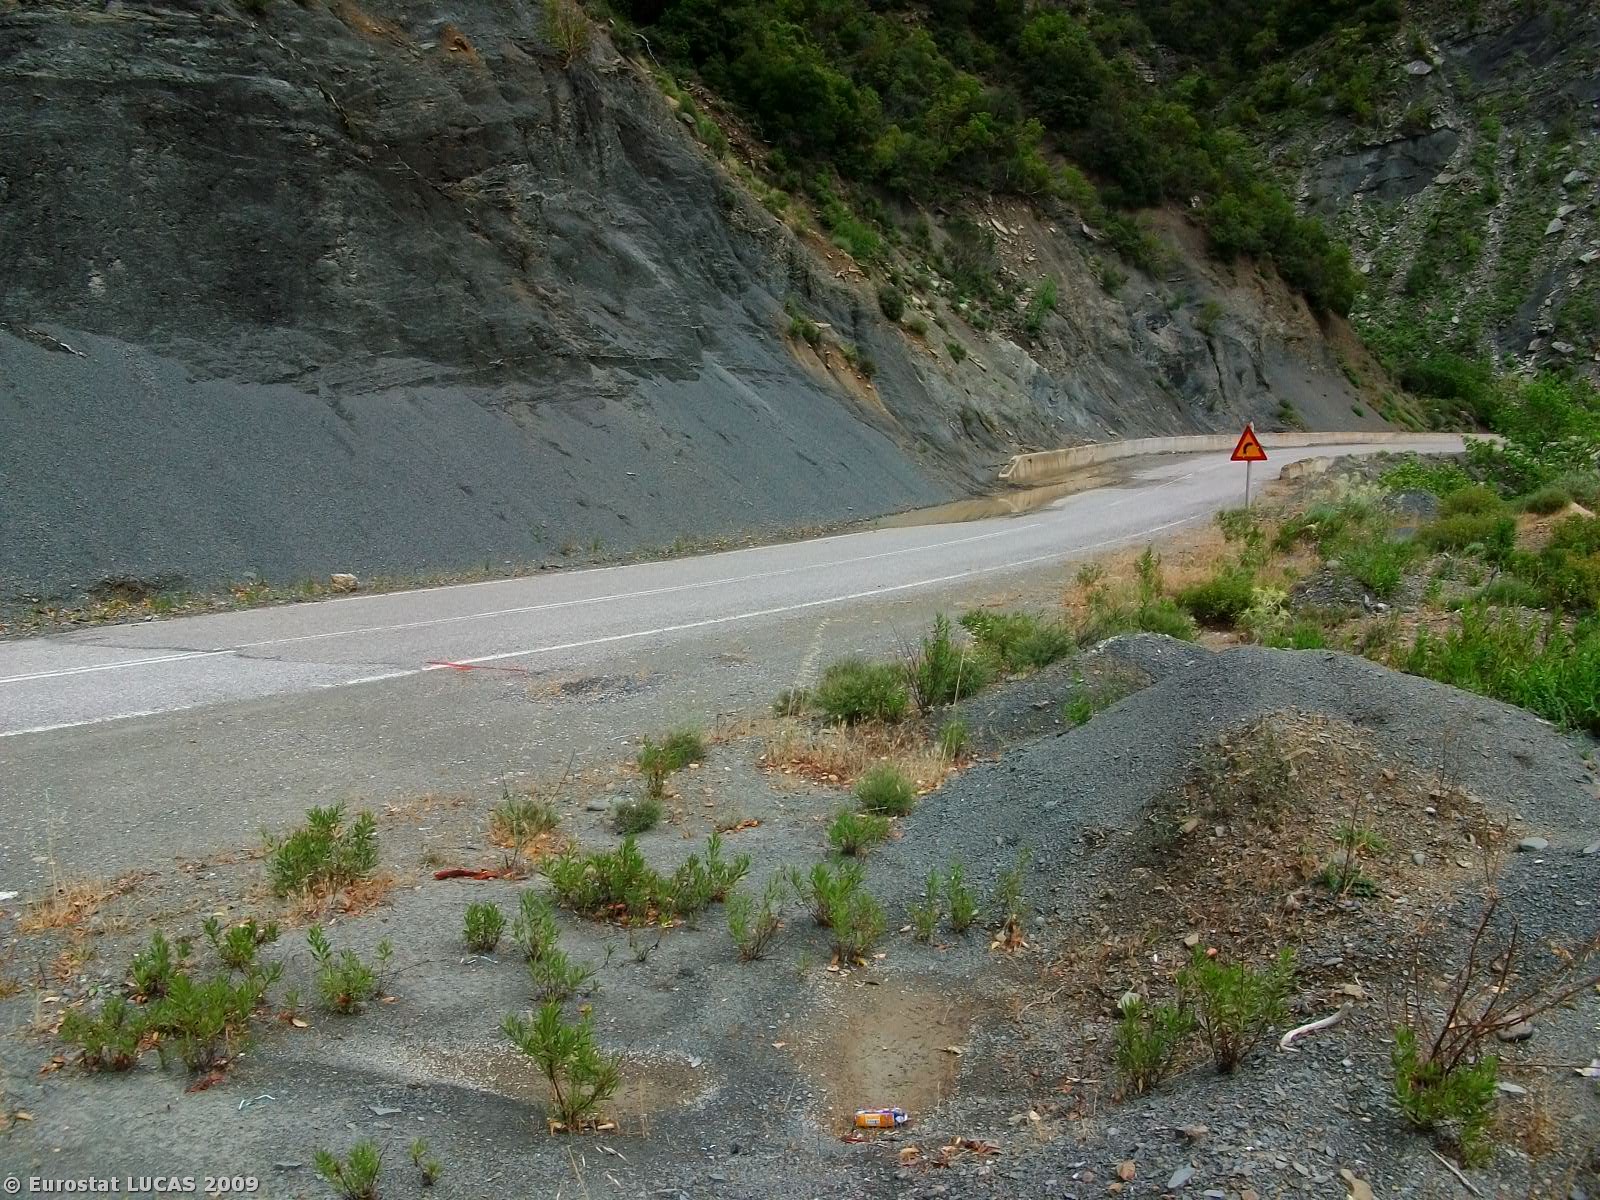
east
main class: Woodland
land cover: Broadleaved woodland
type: thermophilous deciduous forest
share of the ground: > 75 %
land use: Forestry
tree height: > 5 m
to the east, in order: Broadleaved woodland; Rivers and streams; Broadleaved woodland; Bare land; Electric lines; Bare land; Shruby margins; Paved roads, cycling and walking lanes; Grass margins; Bare land; Shrubland without tree cover; Broadleaved woodland
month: June
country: GR
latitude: 38.8695
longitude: 21.5570
